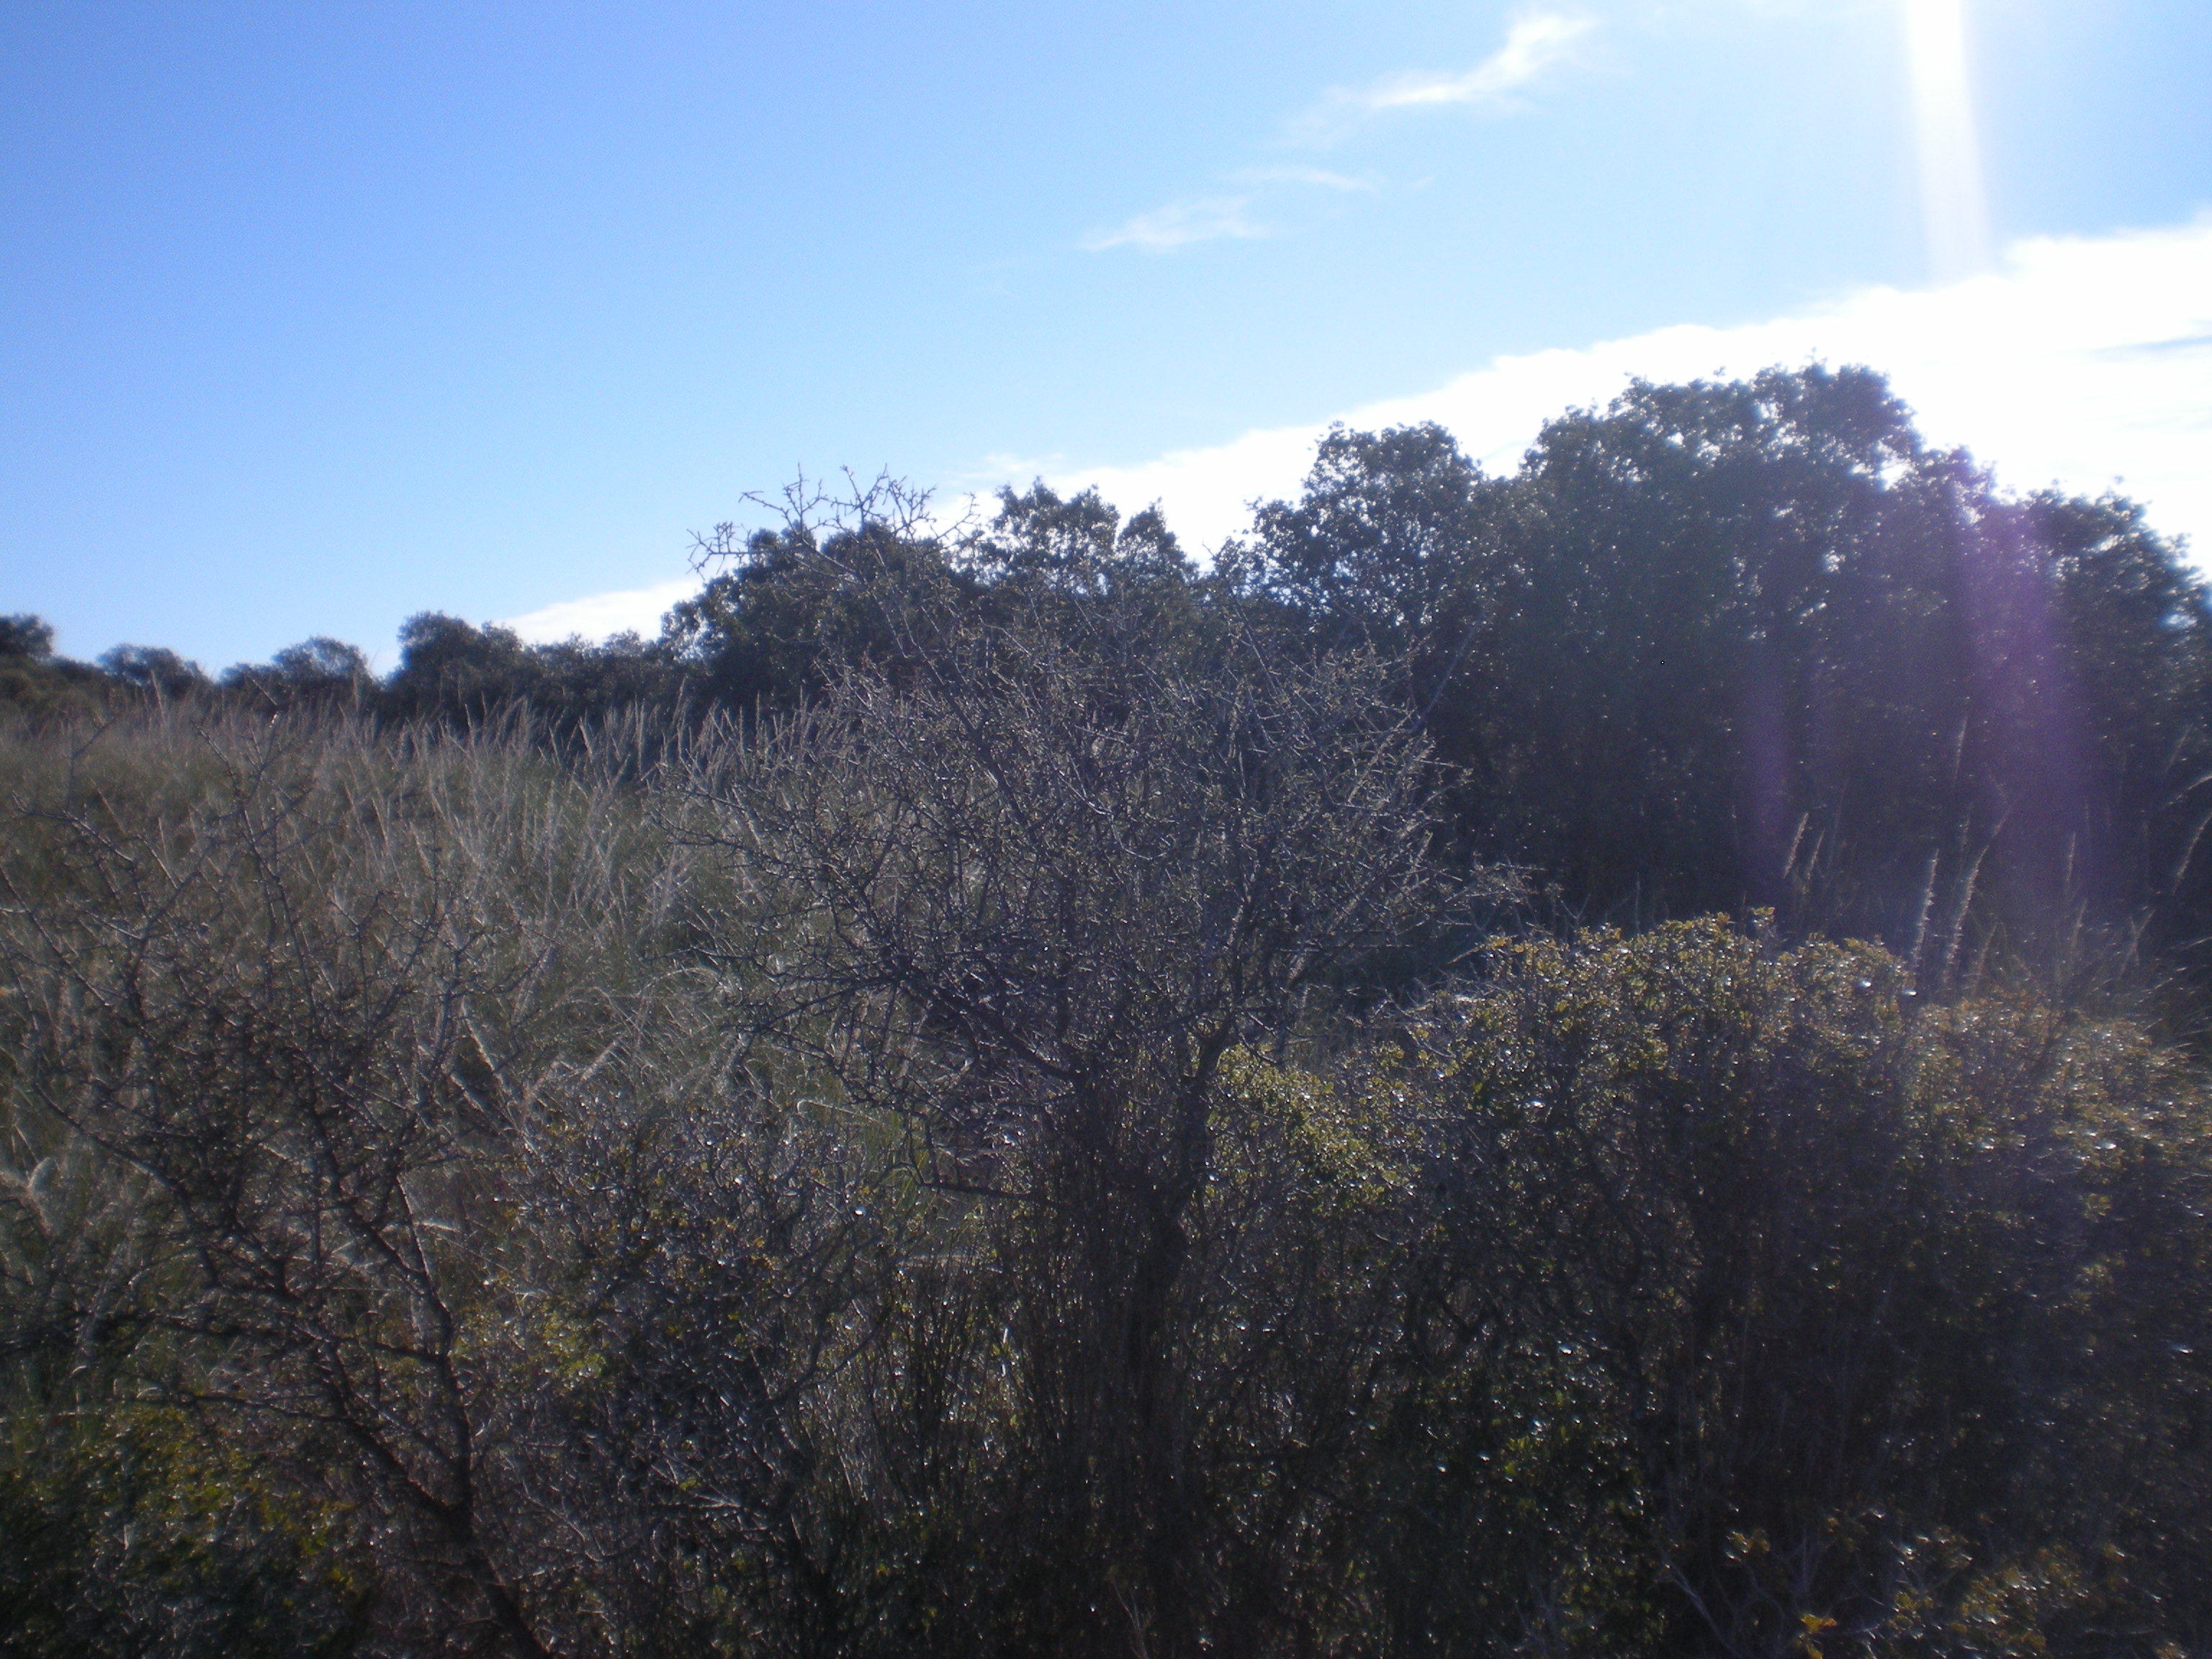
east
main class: Woodland
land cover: Broadleaved woodland
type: broadleaved evergreen forest
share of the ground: 25 - 50 %
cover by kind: shrubs 50 %, broadleaved forest trees 25 %, consolidated bare surface 20 %, herbaceous plants 5 %
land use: Semi-natural and natural areas not in use
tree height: < 5 m
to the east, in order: Broadleaved woodland; Fences; Olive groves; Fences; Abandoned hedges; Olive groves; Broadleaved woodland
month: April
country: ES
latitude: 38.8290
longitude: -3.0131
